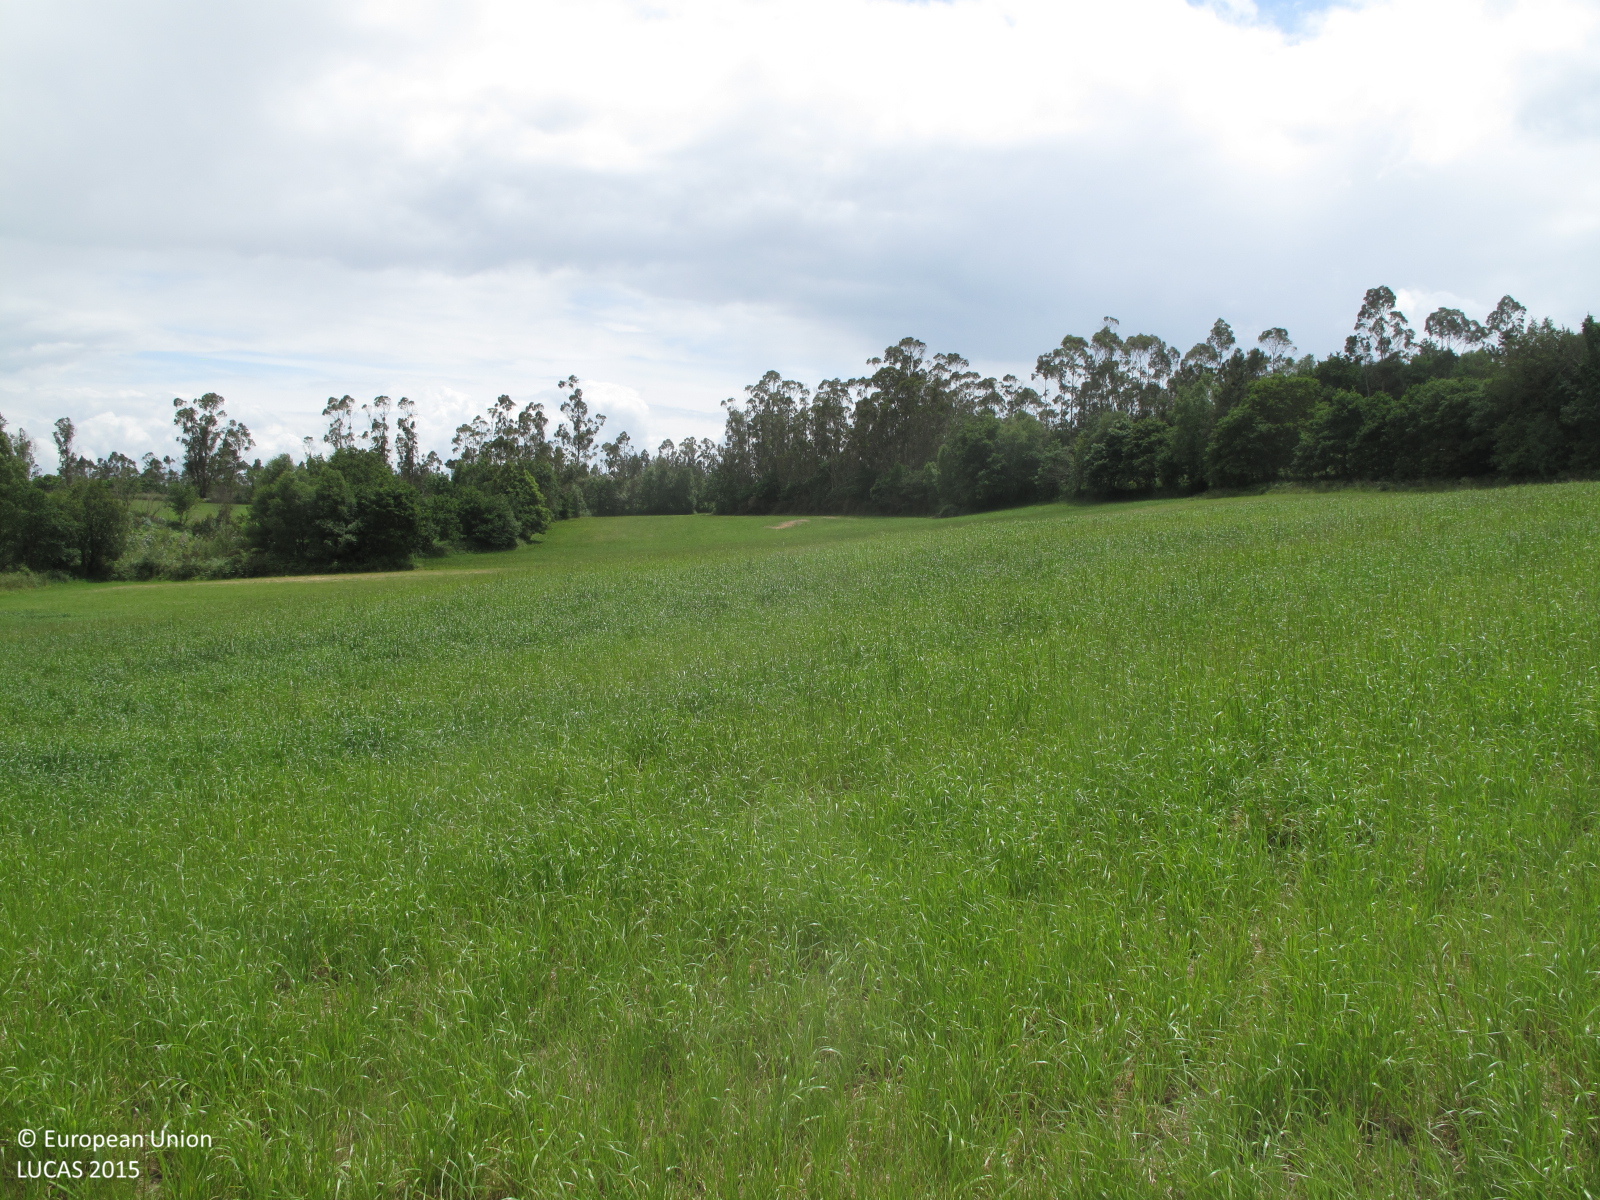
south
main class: Grassland
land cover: Grassland without tree/shrub cover
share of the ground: > 75 %
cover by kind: herbaceous plants 100 %
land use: Agriculture (excluding fallow land and kitchen gardens)
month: June
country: ES
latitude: 43.1073
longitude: -8.5272
